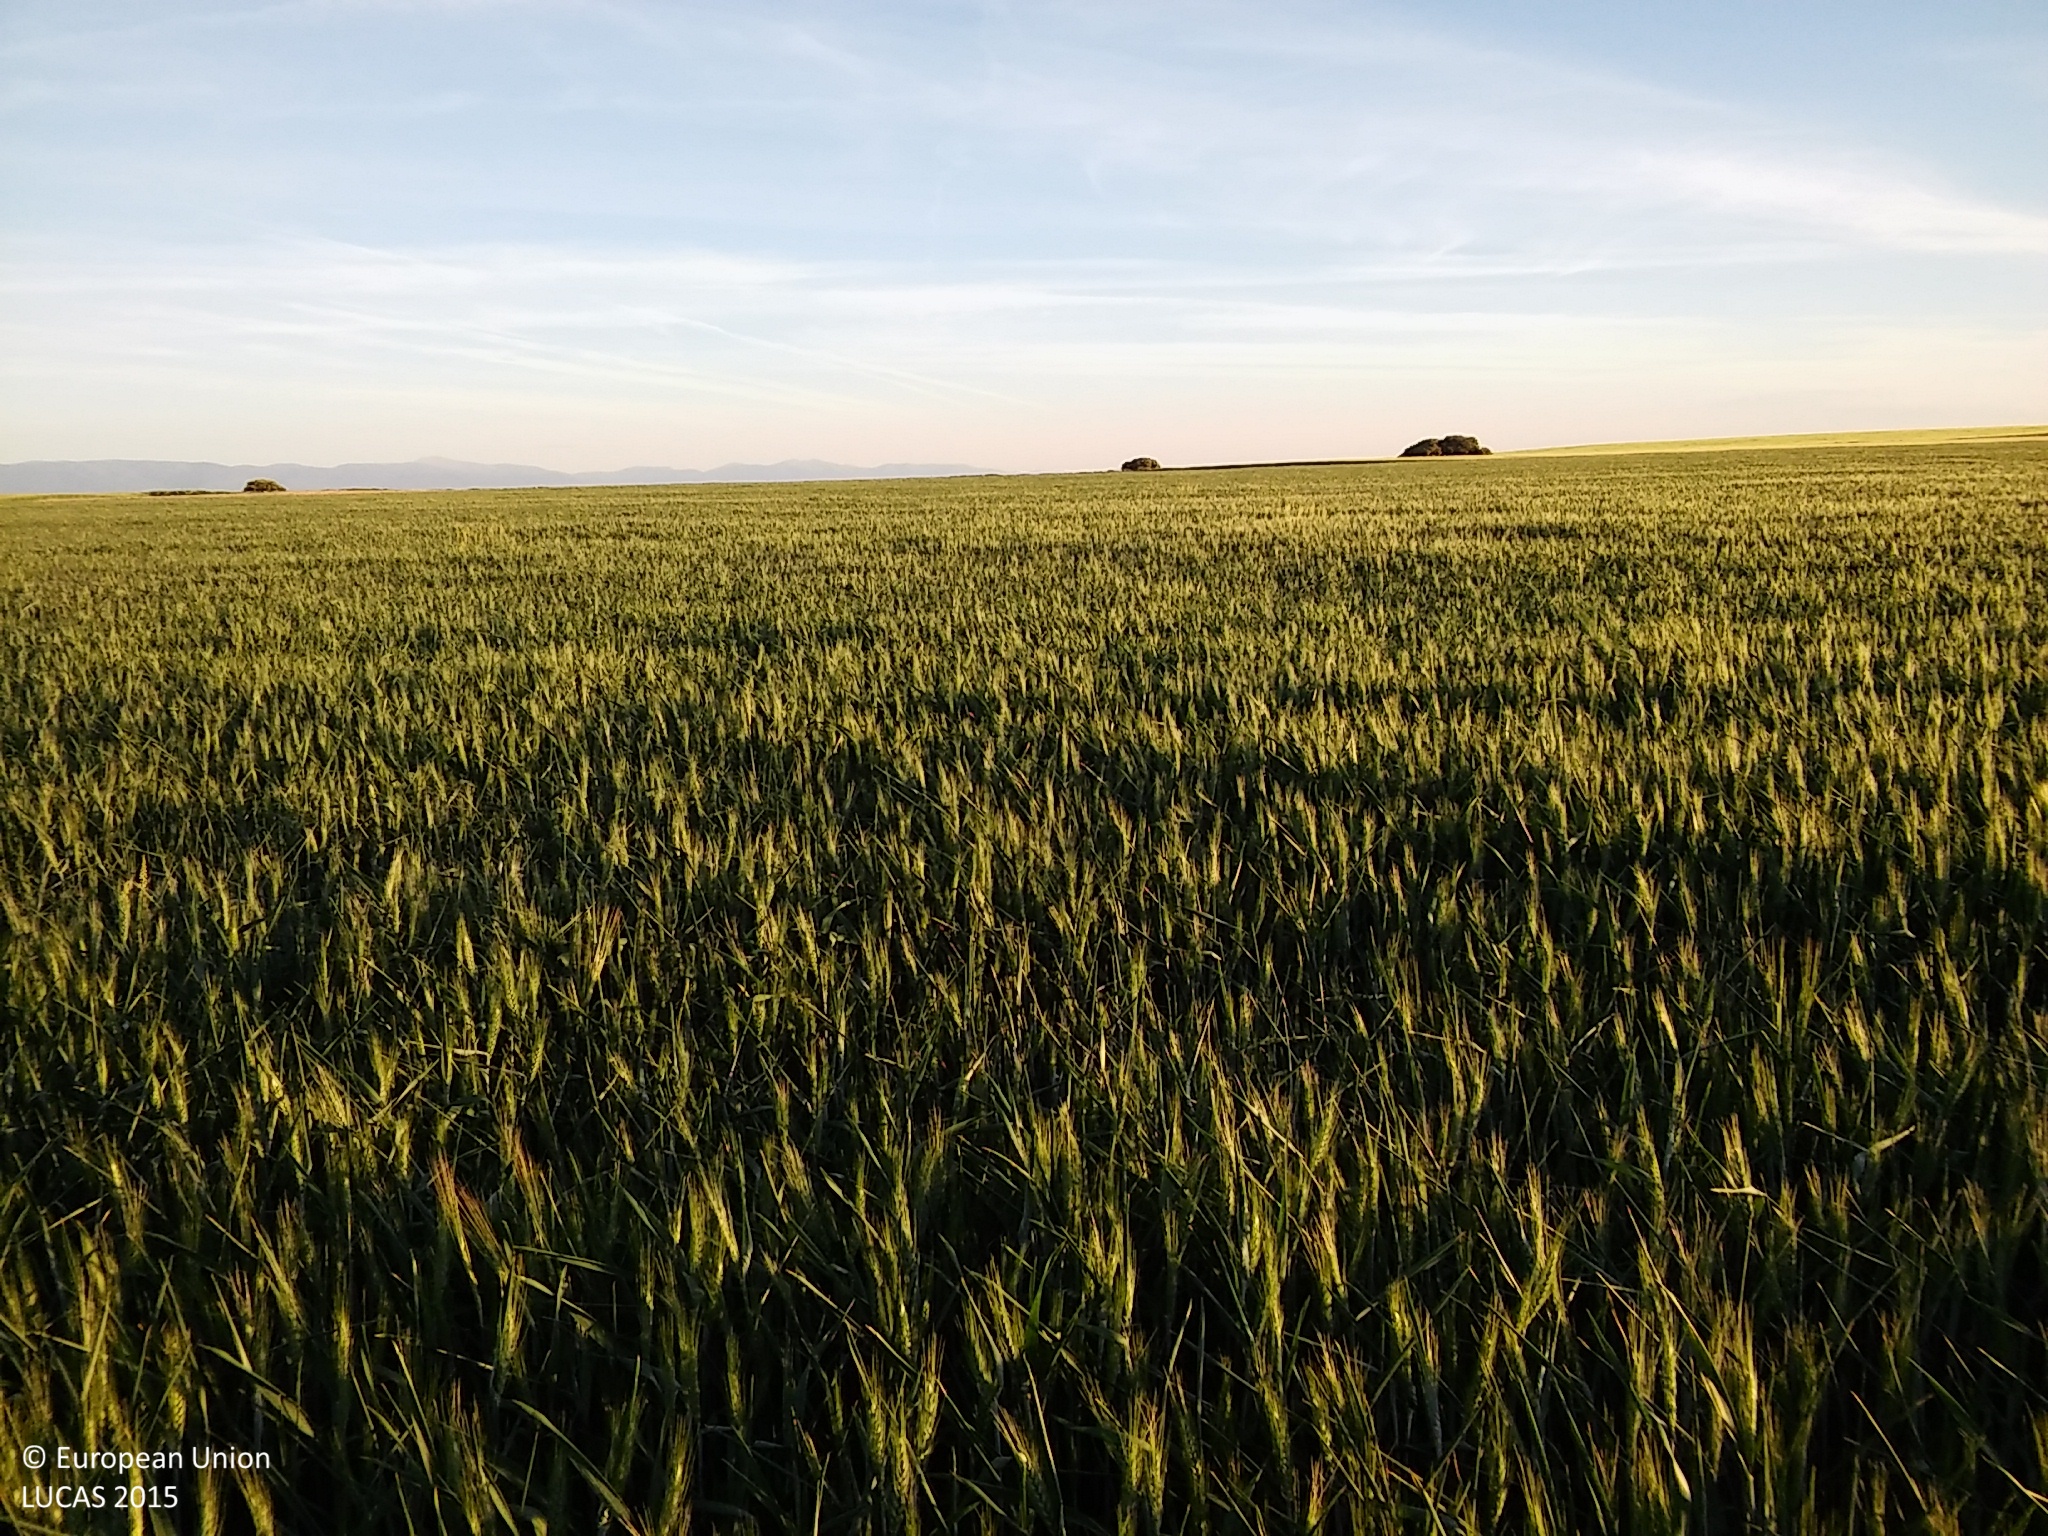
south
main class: Cropland
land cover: Common wheat
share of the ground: > 75 %
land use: Agriculture (excluding fallow land and kitchen gardens)
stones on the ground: 25 - 50 %
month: May
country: ES
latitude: 41.3998
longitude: -4.0129
